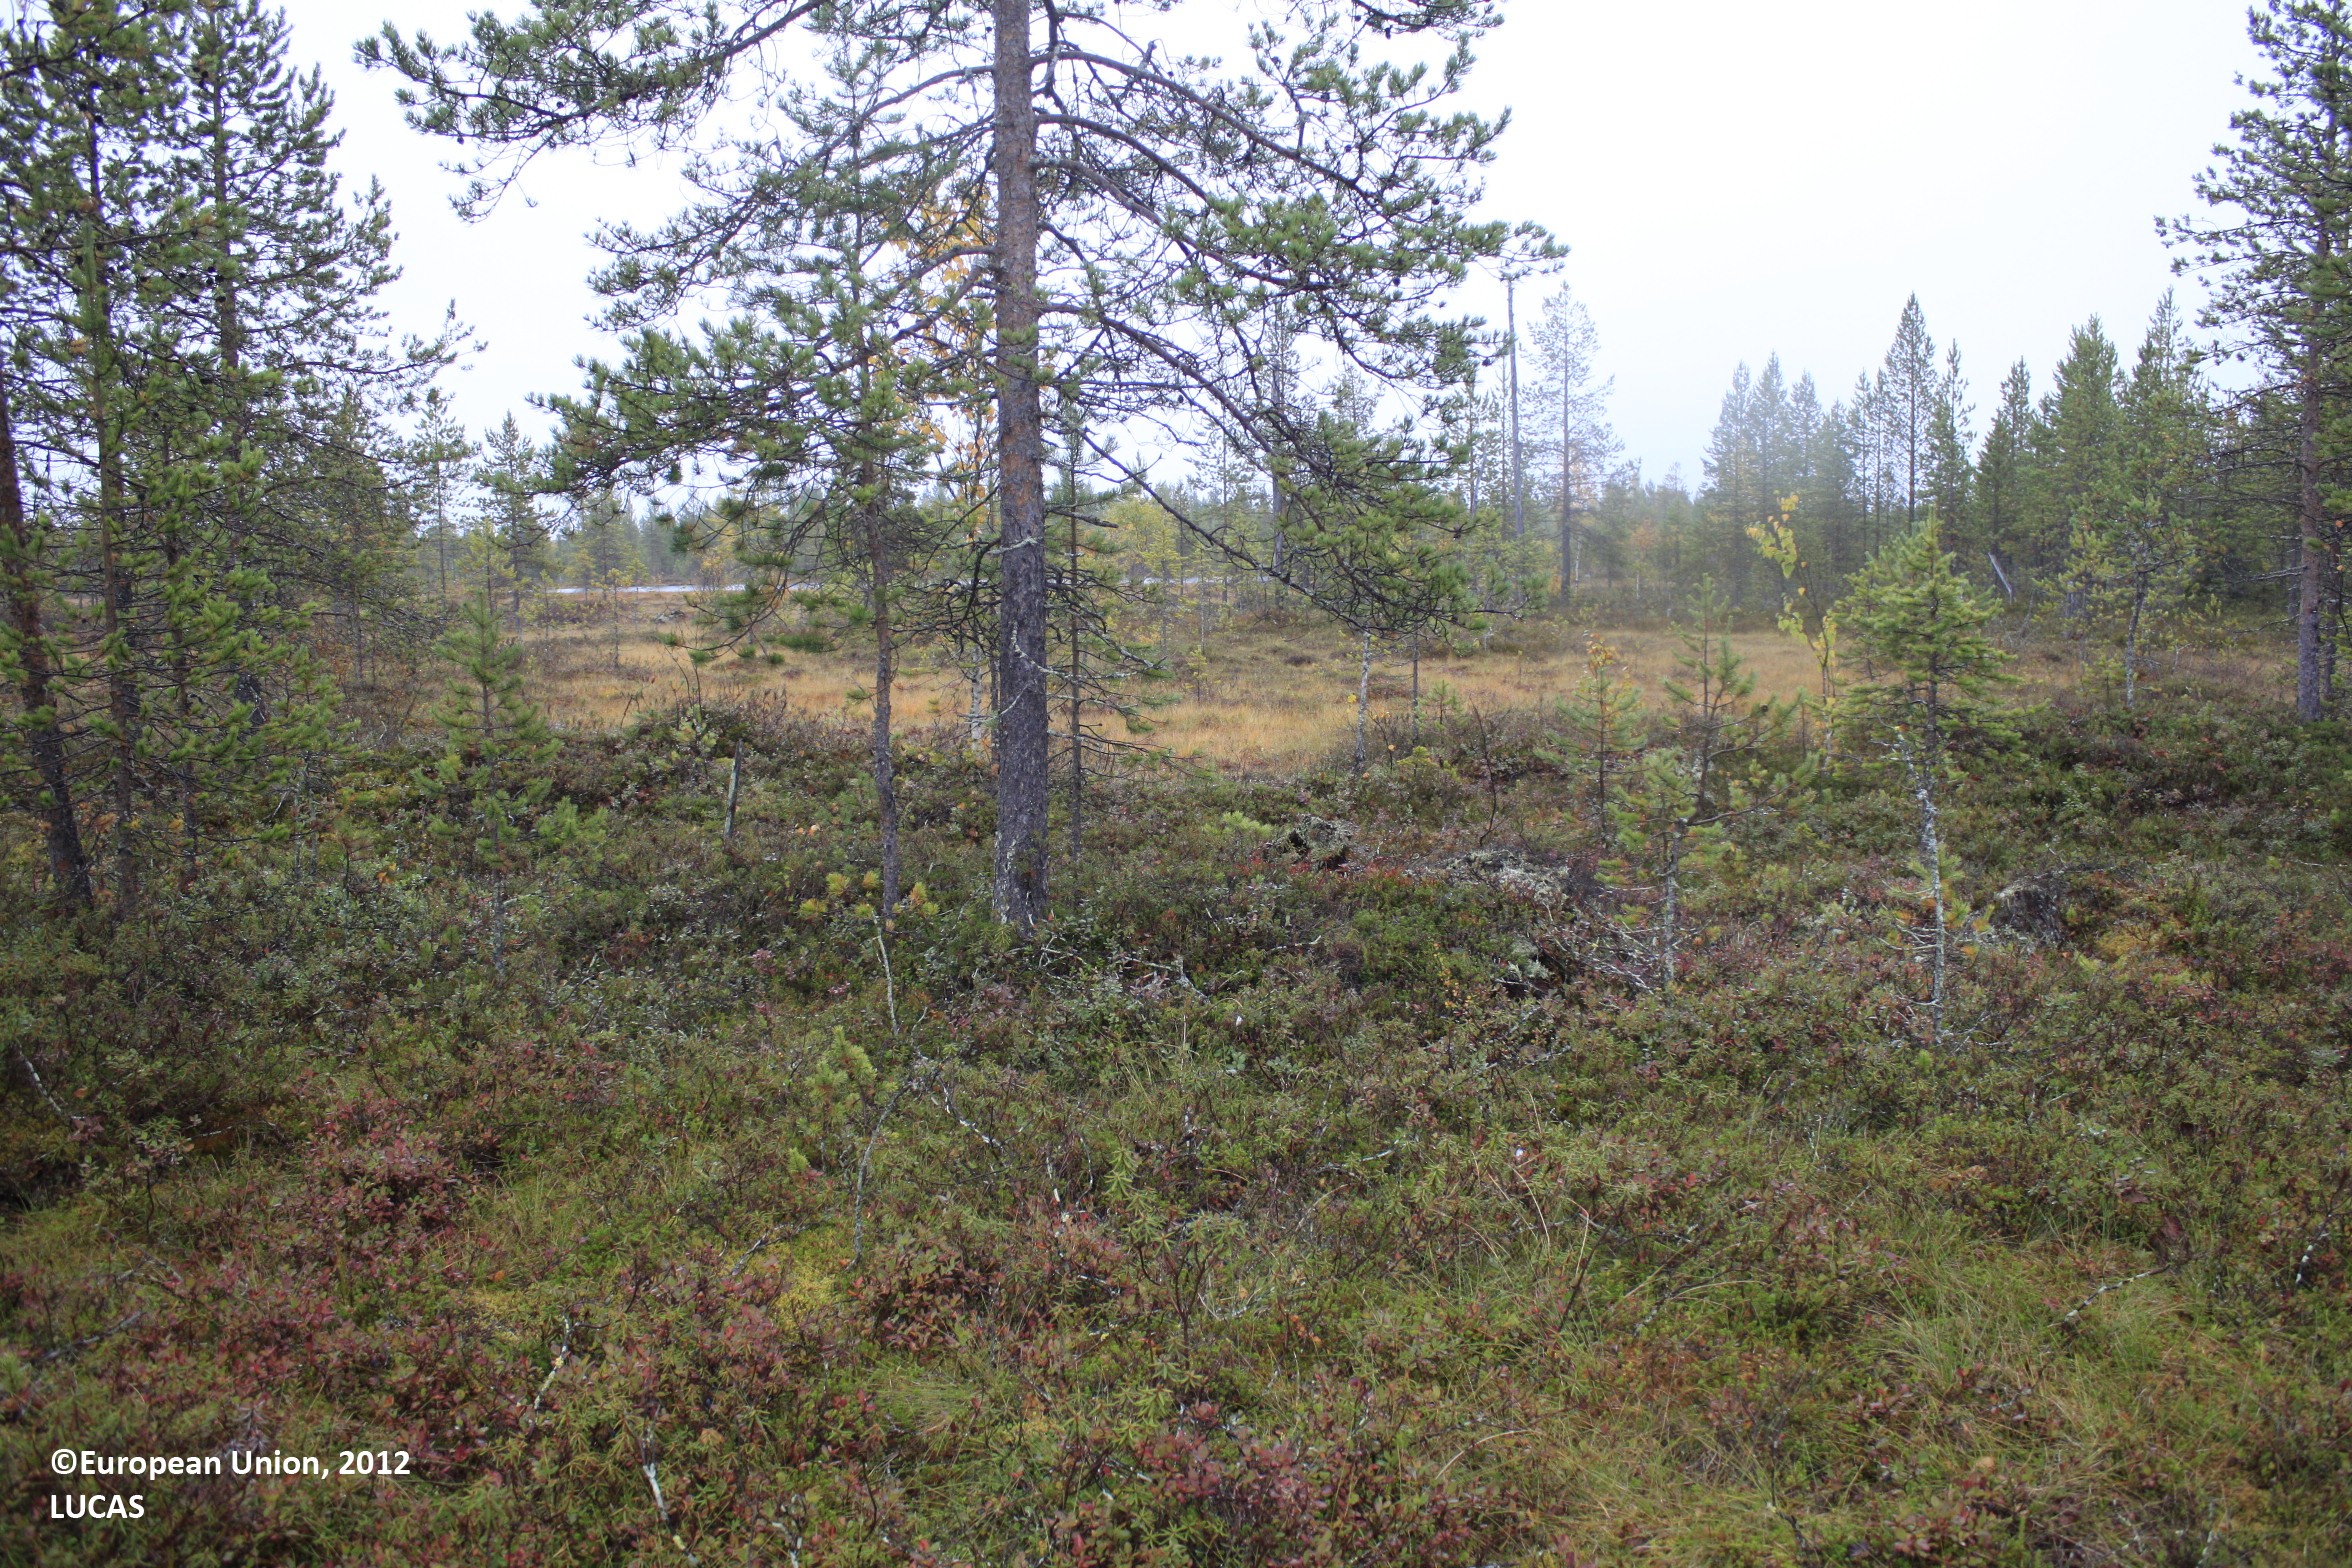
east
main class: Woodland
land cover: Pine dominated mixed woodland
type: mire and swamp forests
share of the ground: 25 - 50 %
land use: Forestry
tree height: < 5 m
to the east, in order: Pine dominated mixed woodland; Peatbogs; Inland water bodies; Peatbogs; Pine dominated mixed woodland
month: September
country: FI
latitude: 65.9329
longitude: 27.2794
